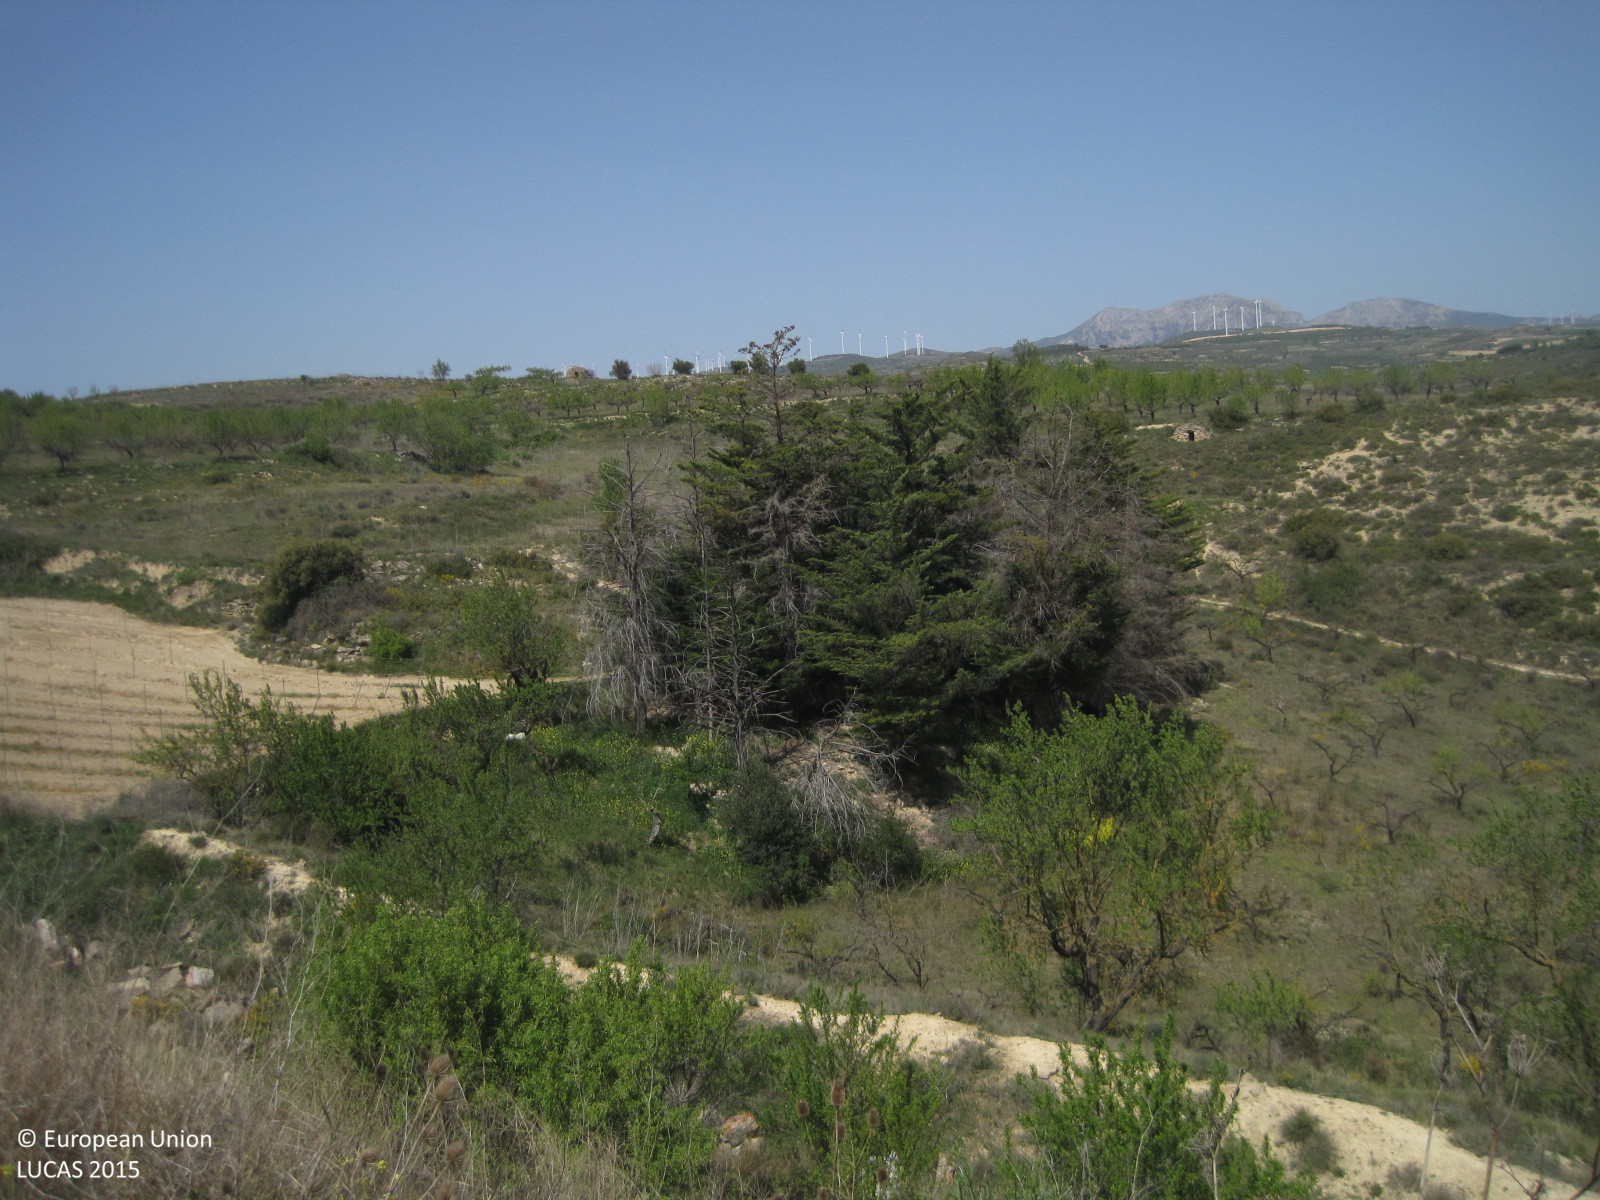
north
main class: Grassland
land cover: Grassland without tree/shrub cover
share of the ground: > 75 %
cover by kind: herbaceous plants 90 %, shrubs 5 %, consolidated bare surface 5 %
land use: Semi-natural and natural areas not in use
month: April
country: ES
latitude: 42.5304
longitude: -2.3773
